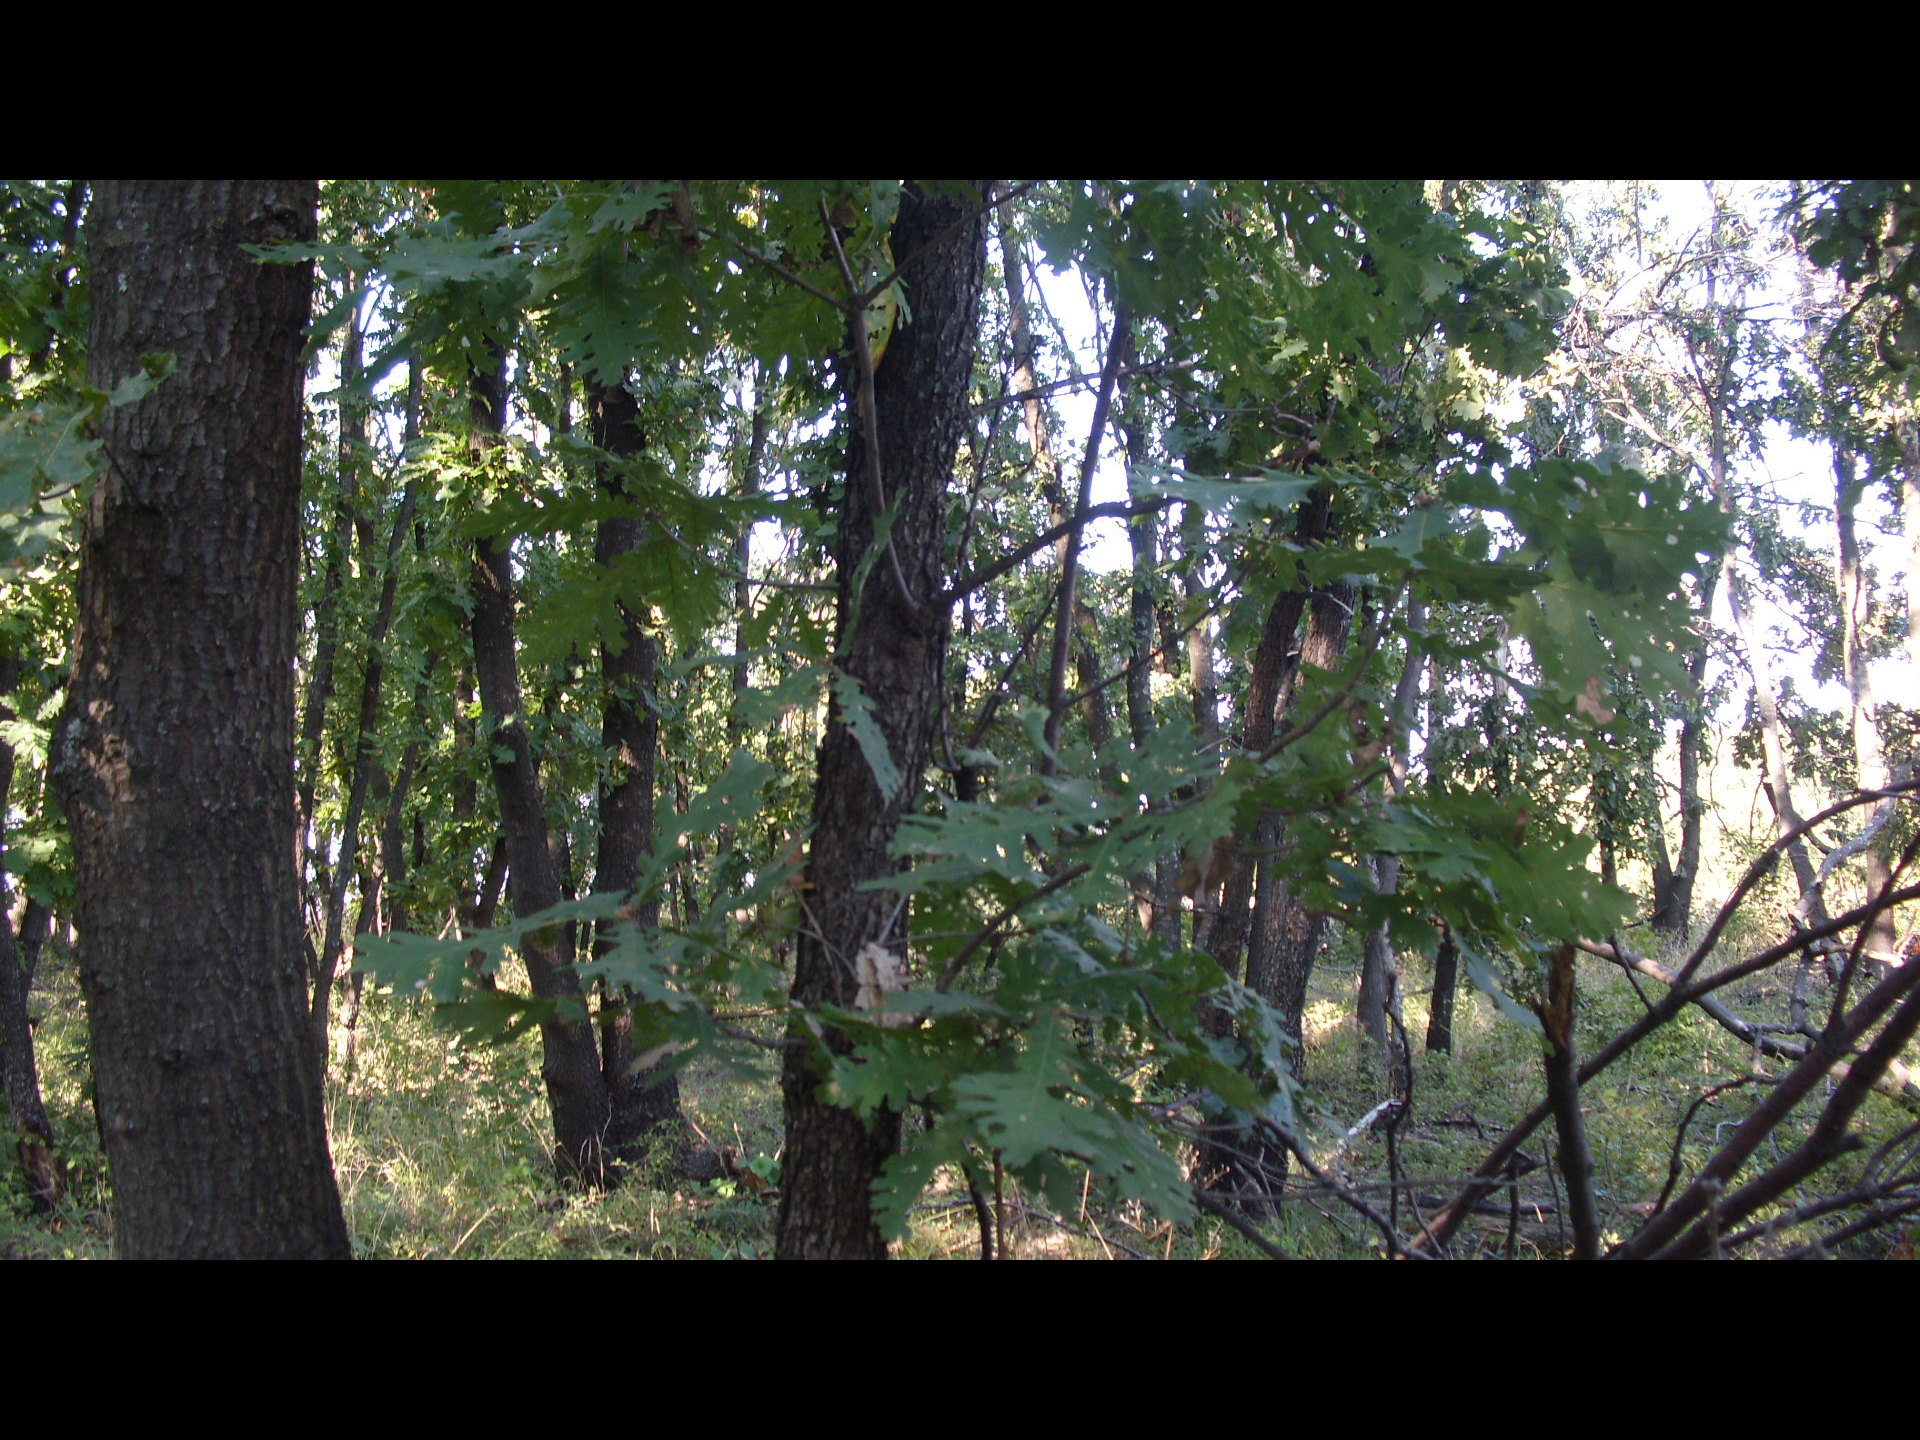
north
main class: Woodland
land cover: Broadleaved woodland
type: mesophytic deciduous forest
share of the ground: > 75 %
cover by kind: broadleaved forest trees 85 %, herbaceous plants 15 %
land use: Forestry
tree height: > 5 m
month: October
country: BG
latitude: 43.8693
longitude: 22.4641
